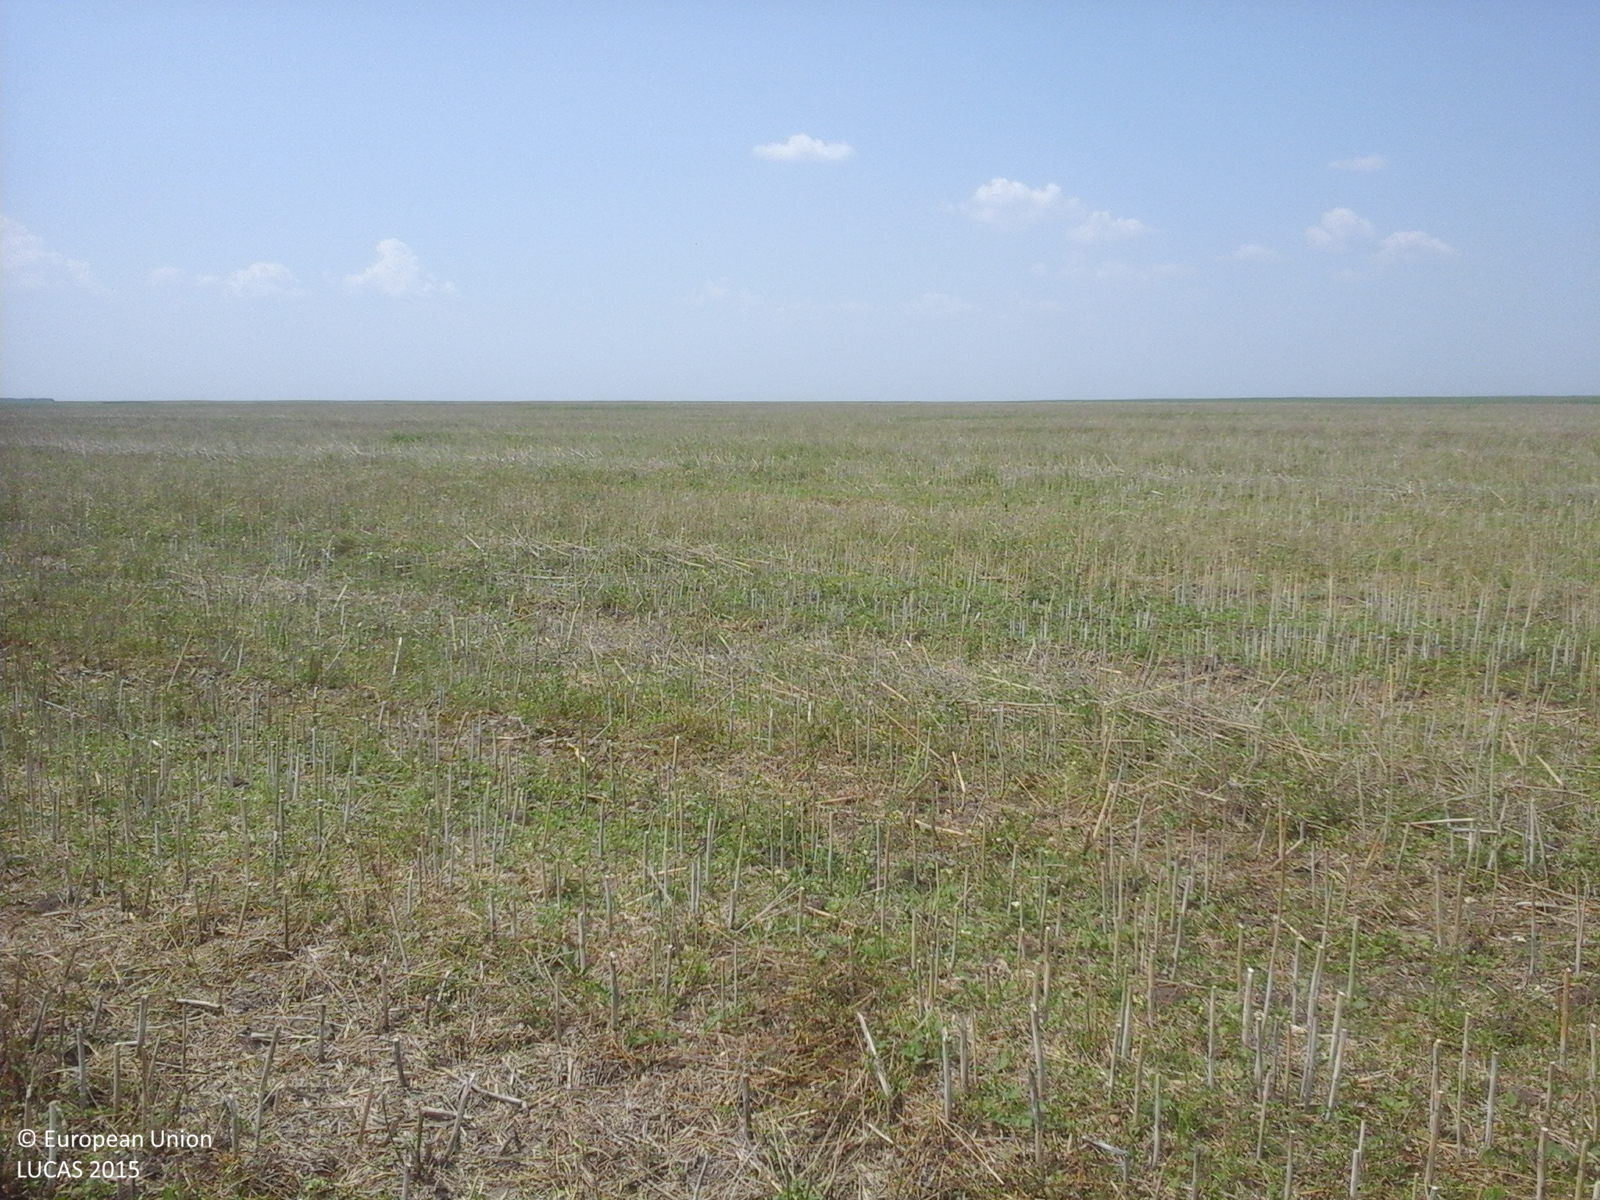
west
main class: Cropland
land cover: Rape and turnip rape
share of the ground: < 10 %
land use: Agriculture (excluding fallow land and kitchen gardens)
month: July
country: RO
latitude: 44.5187
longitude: 24.8610
